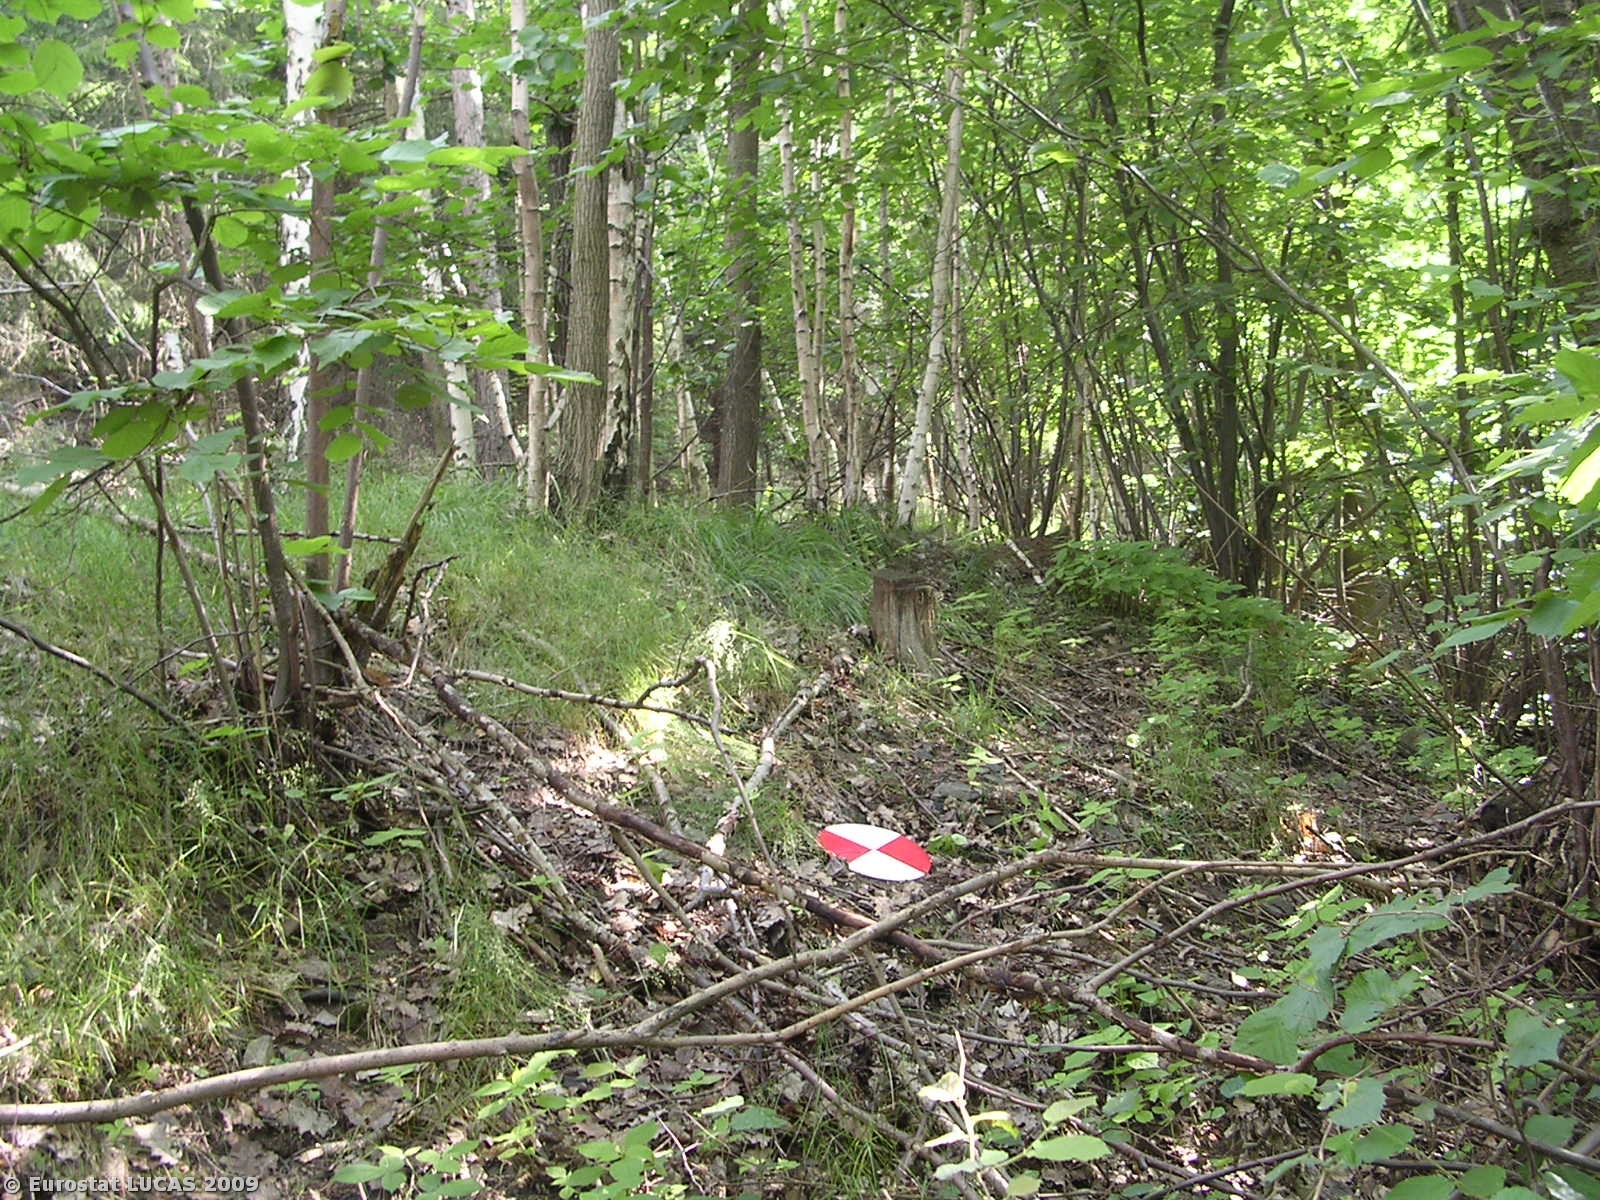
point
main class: Woodland
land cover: Broadleaved woodland
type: non-riverine alder, birch or aspen forest
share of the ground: > 75 %
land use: Forestry
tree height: > 5 m
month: June
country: CZ
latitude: 50.5911
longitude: 14.2532
